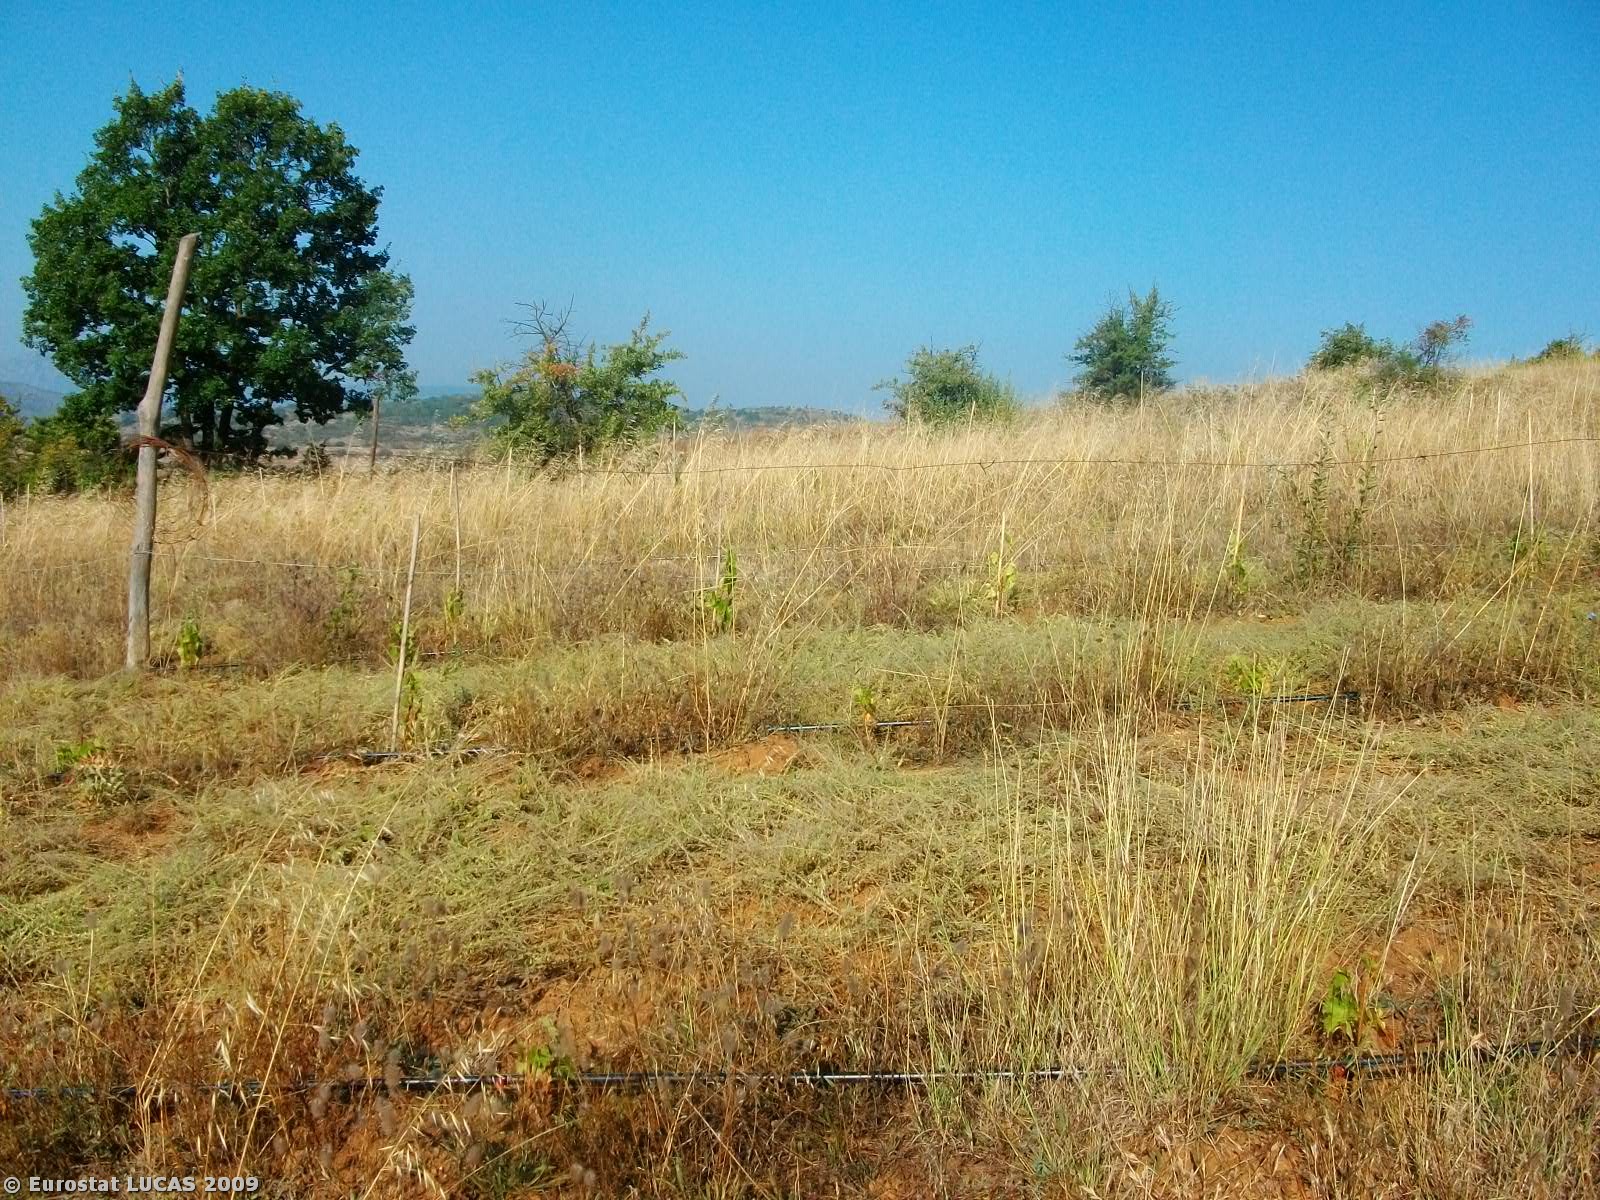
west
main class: Cropland
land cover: Vineyards
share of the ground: < 10 %
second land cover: Grassland with sparse tree/shrub cover
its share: > 75 %
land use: Agriculture (excluding fallow land and kitchen gardens)
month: May
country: GR
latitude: 40.7870
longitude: 21.8599
